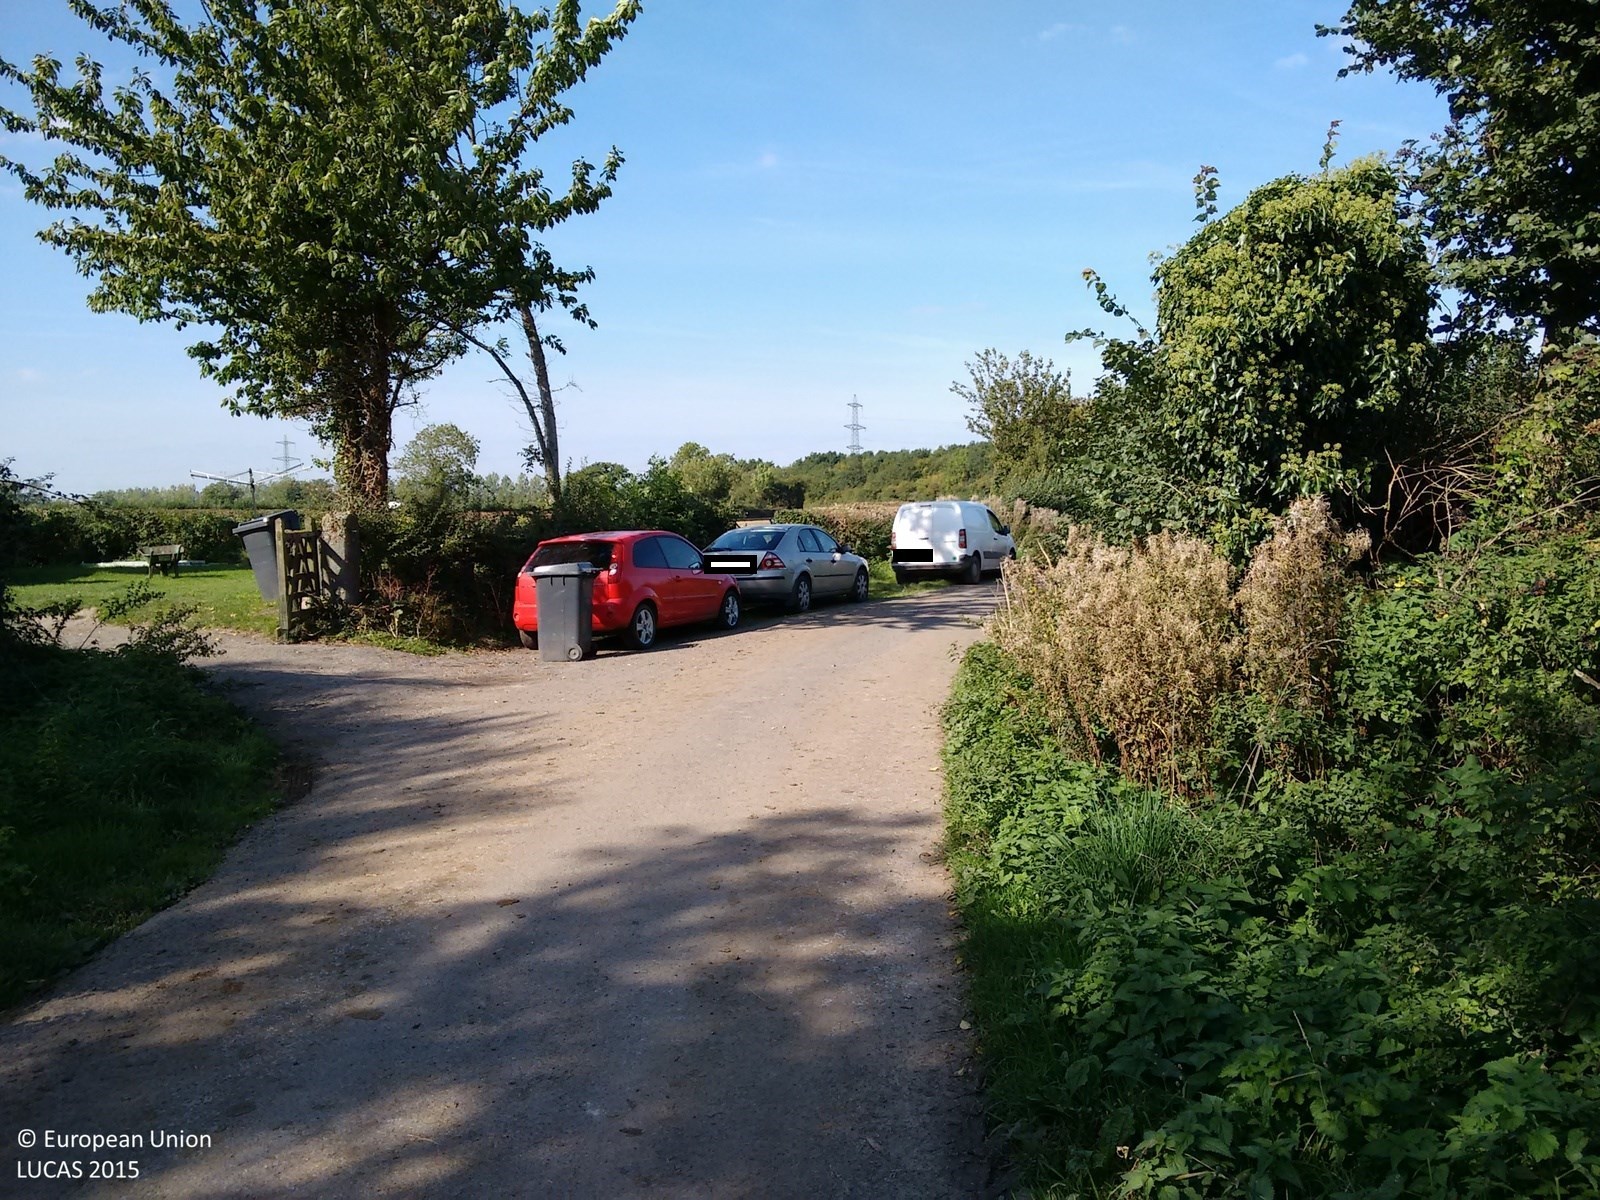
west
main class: Grassland
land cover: Grassland without tree/shrub cover
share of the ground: > 75 %
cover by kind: herbaceous plants 100 %
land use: Agriculture (excluding fallow land and kitchen gardens)
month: September
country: GB
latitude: 51.5745
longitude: -2.6072
